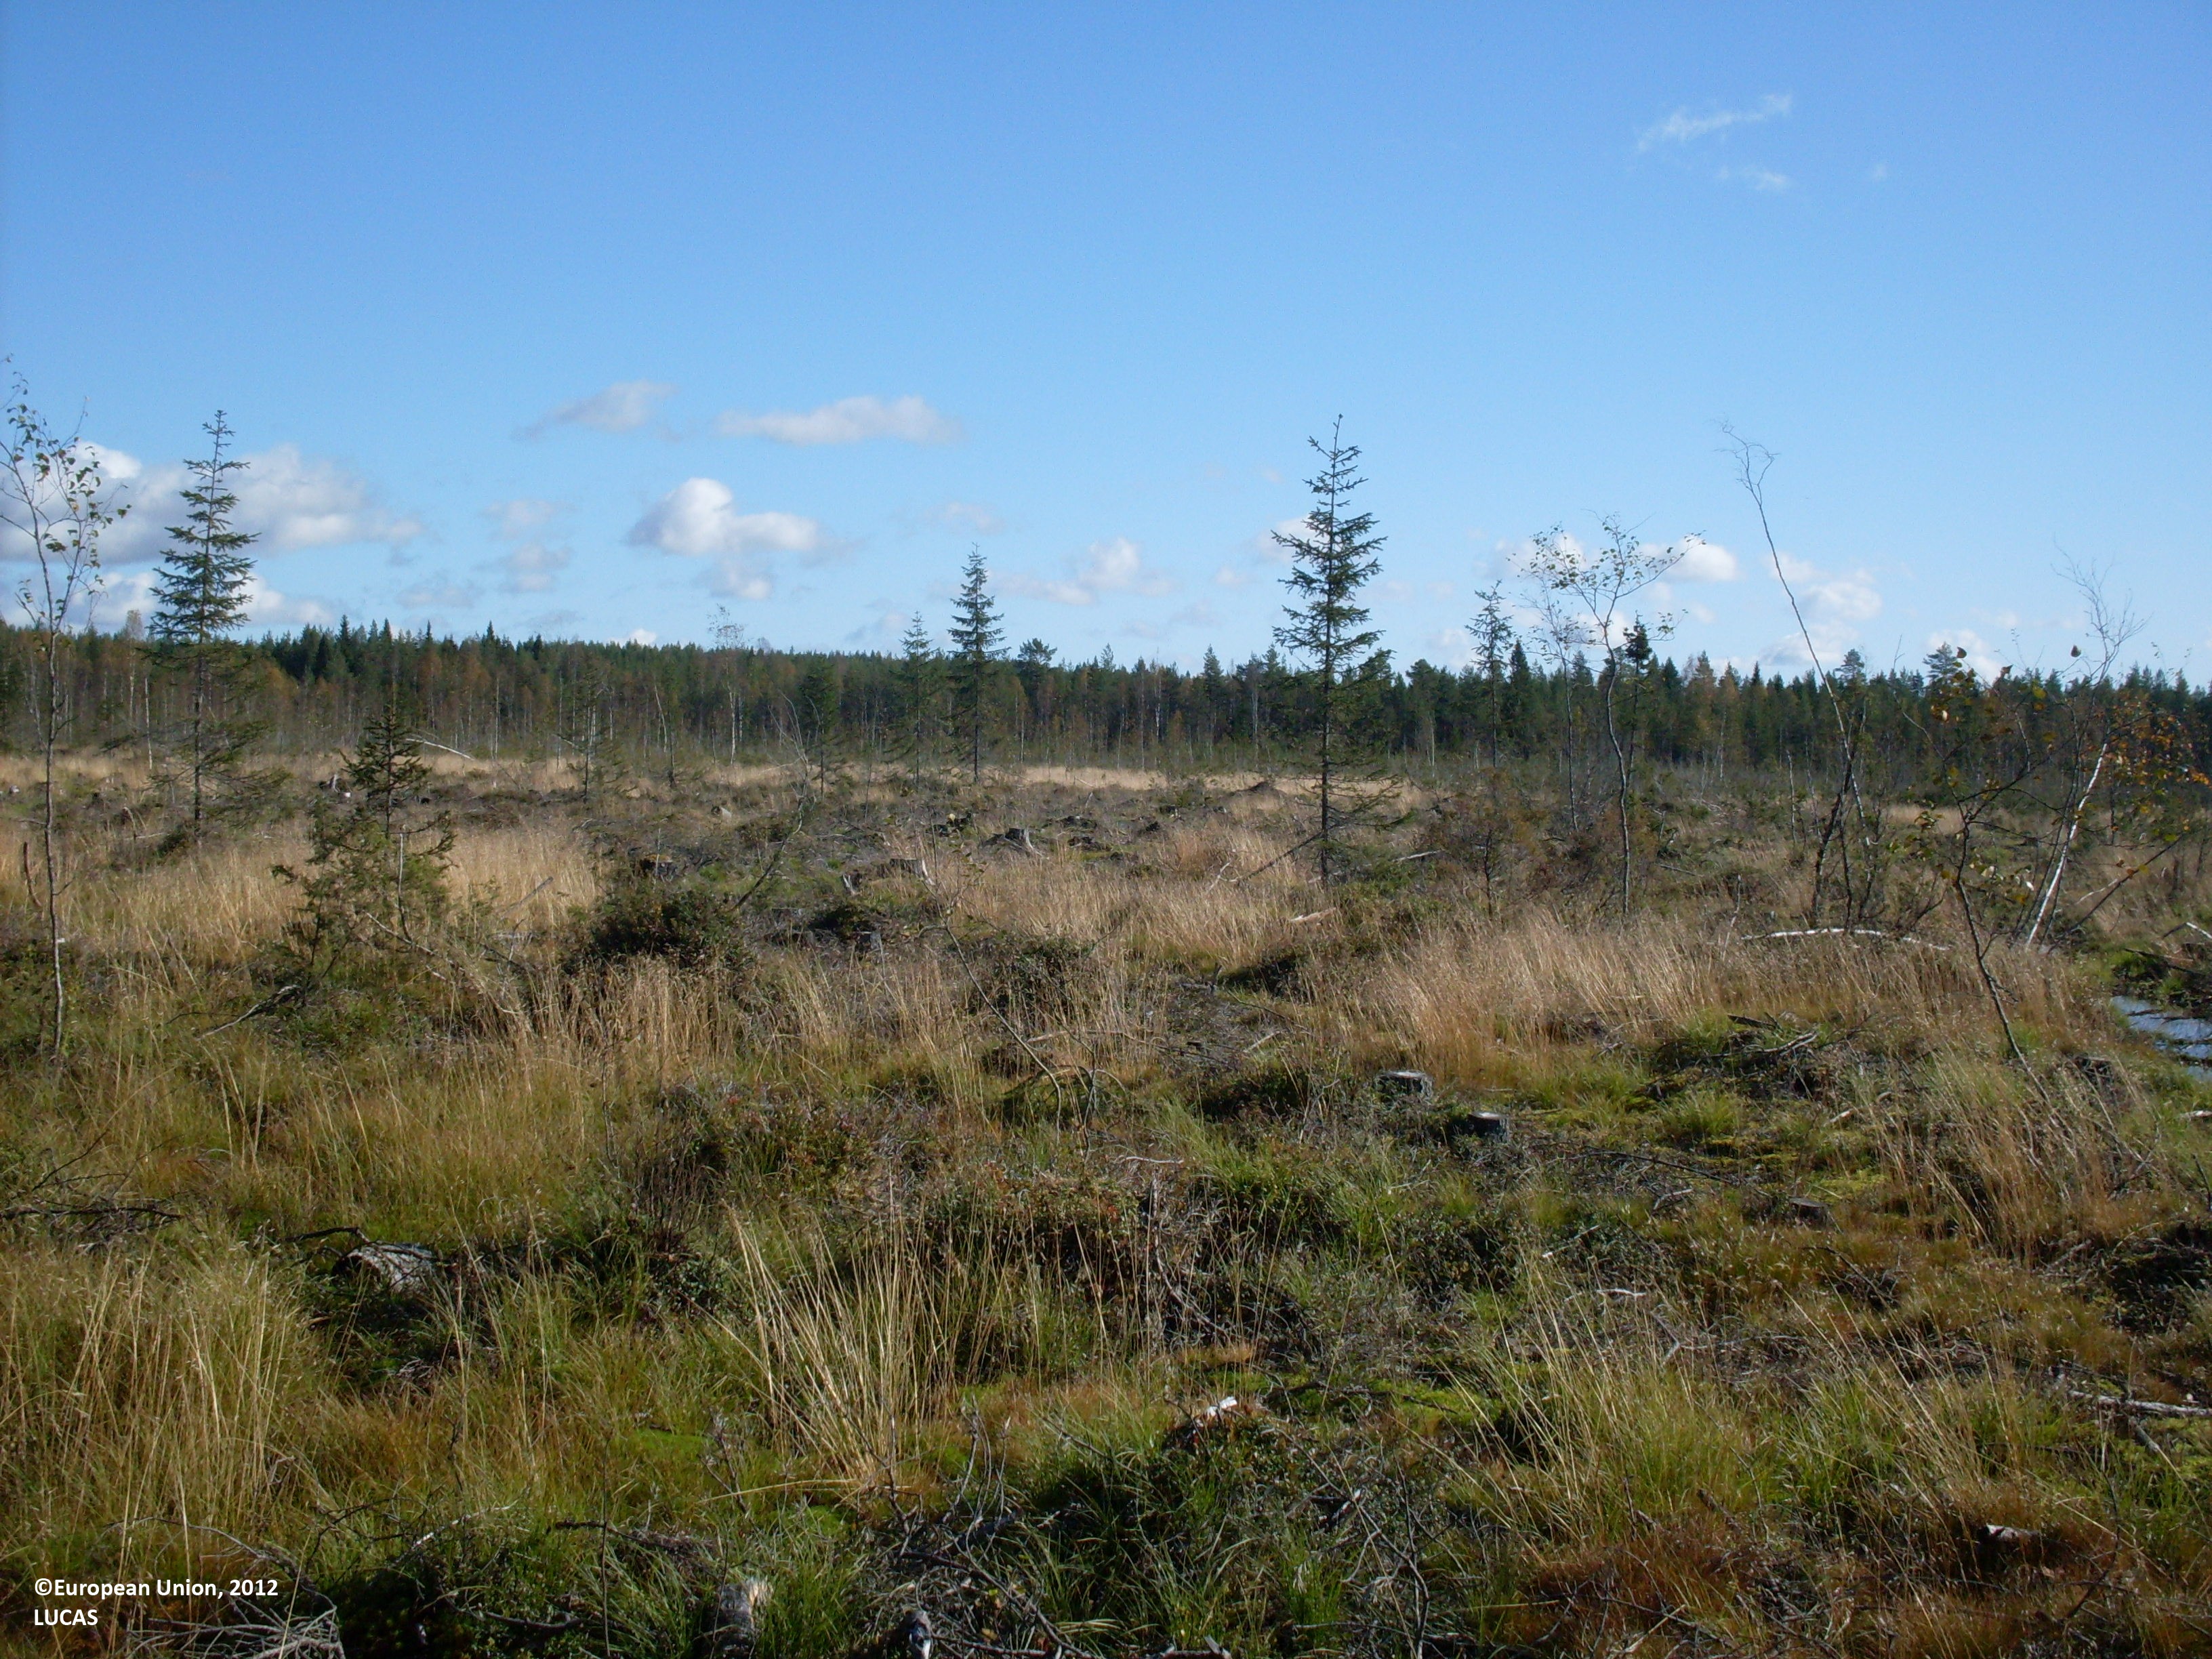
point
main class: Woodland
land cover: Pine dominated mixed woodland
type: boreal forest
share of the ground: 50 - 75 %
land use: Forestry
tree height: > 5 m
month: September
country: FI
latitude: 64.3059
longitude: 28.4725
